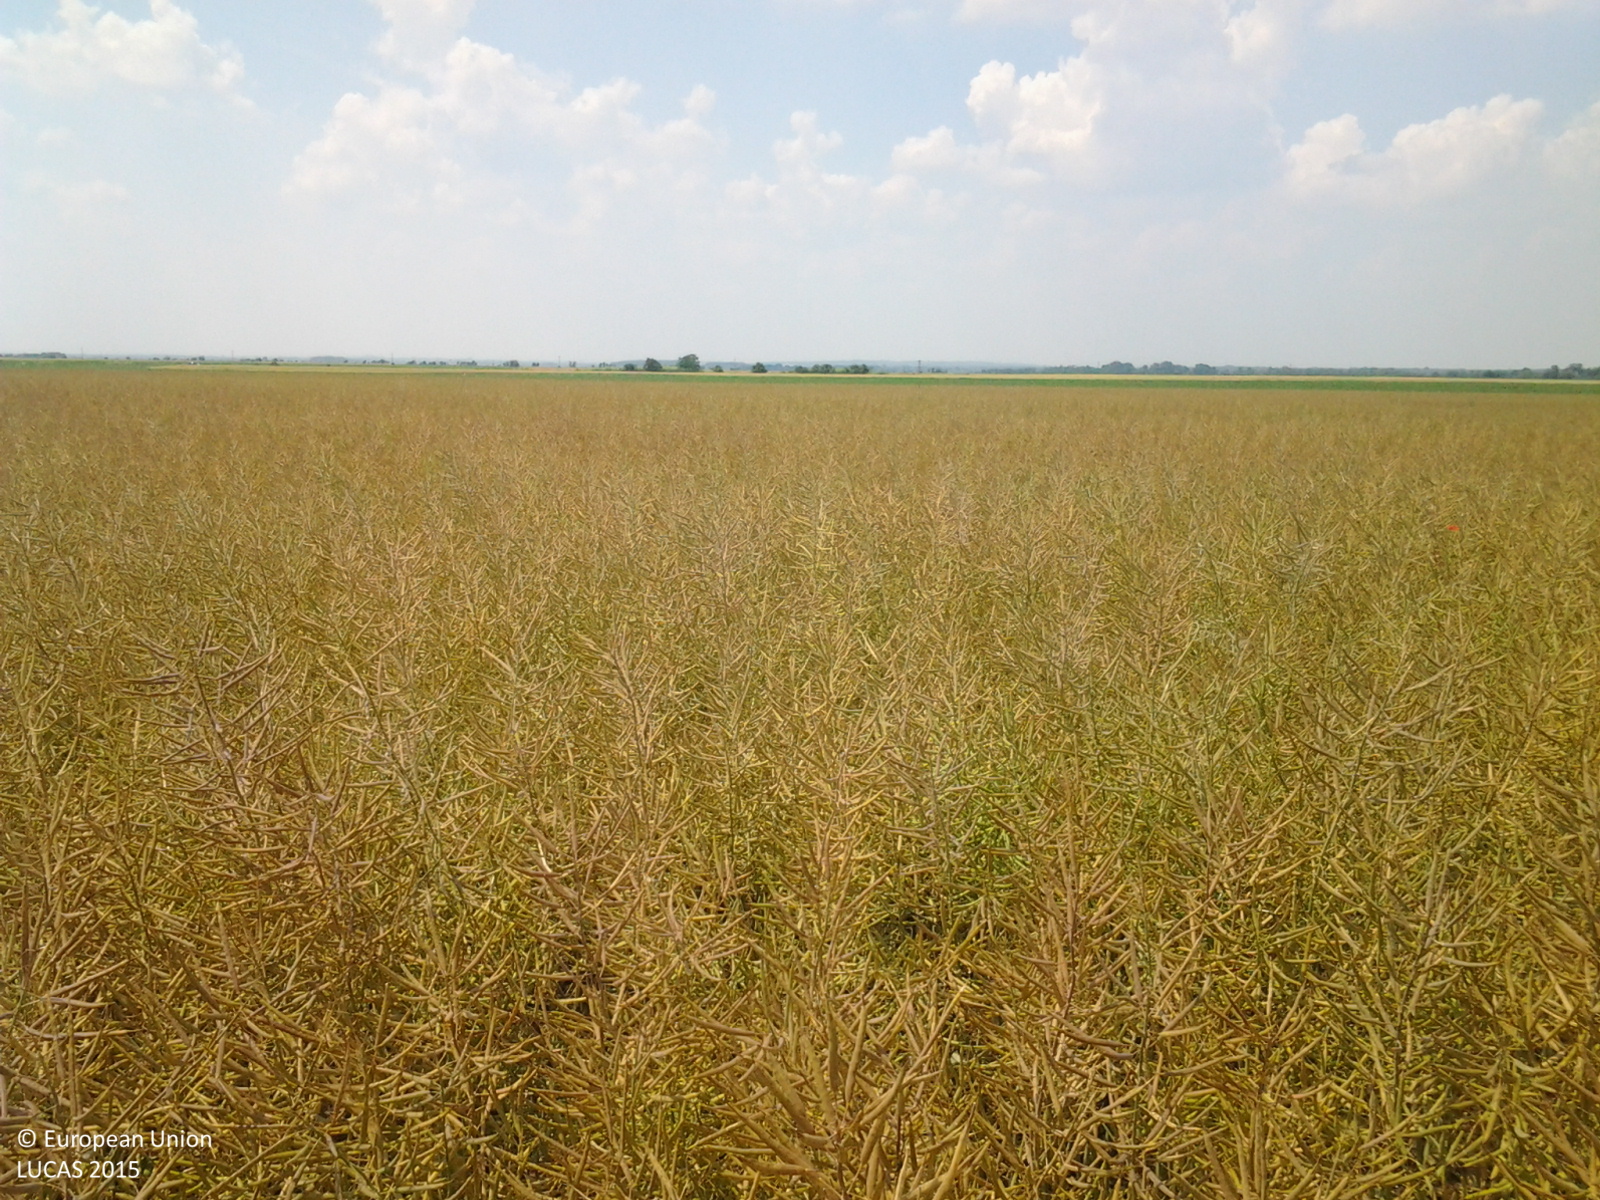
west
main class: Cropland
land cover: Rape and turnip rape
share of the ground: > 75 %
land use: Agriculture (excluding fallow land and kitchen gardens)
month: June
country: HU
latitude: 46.6223
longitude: 19.0122
